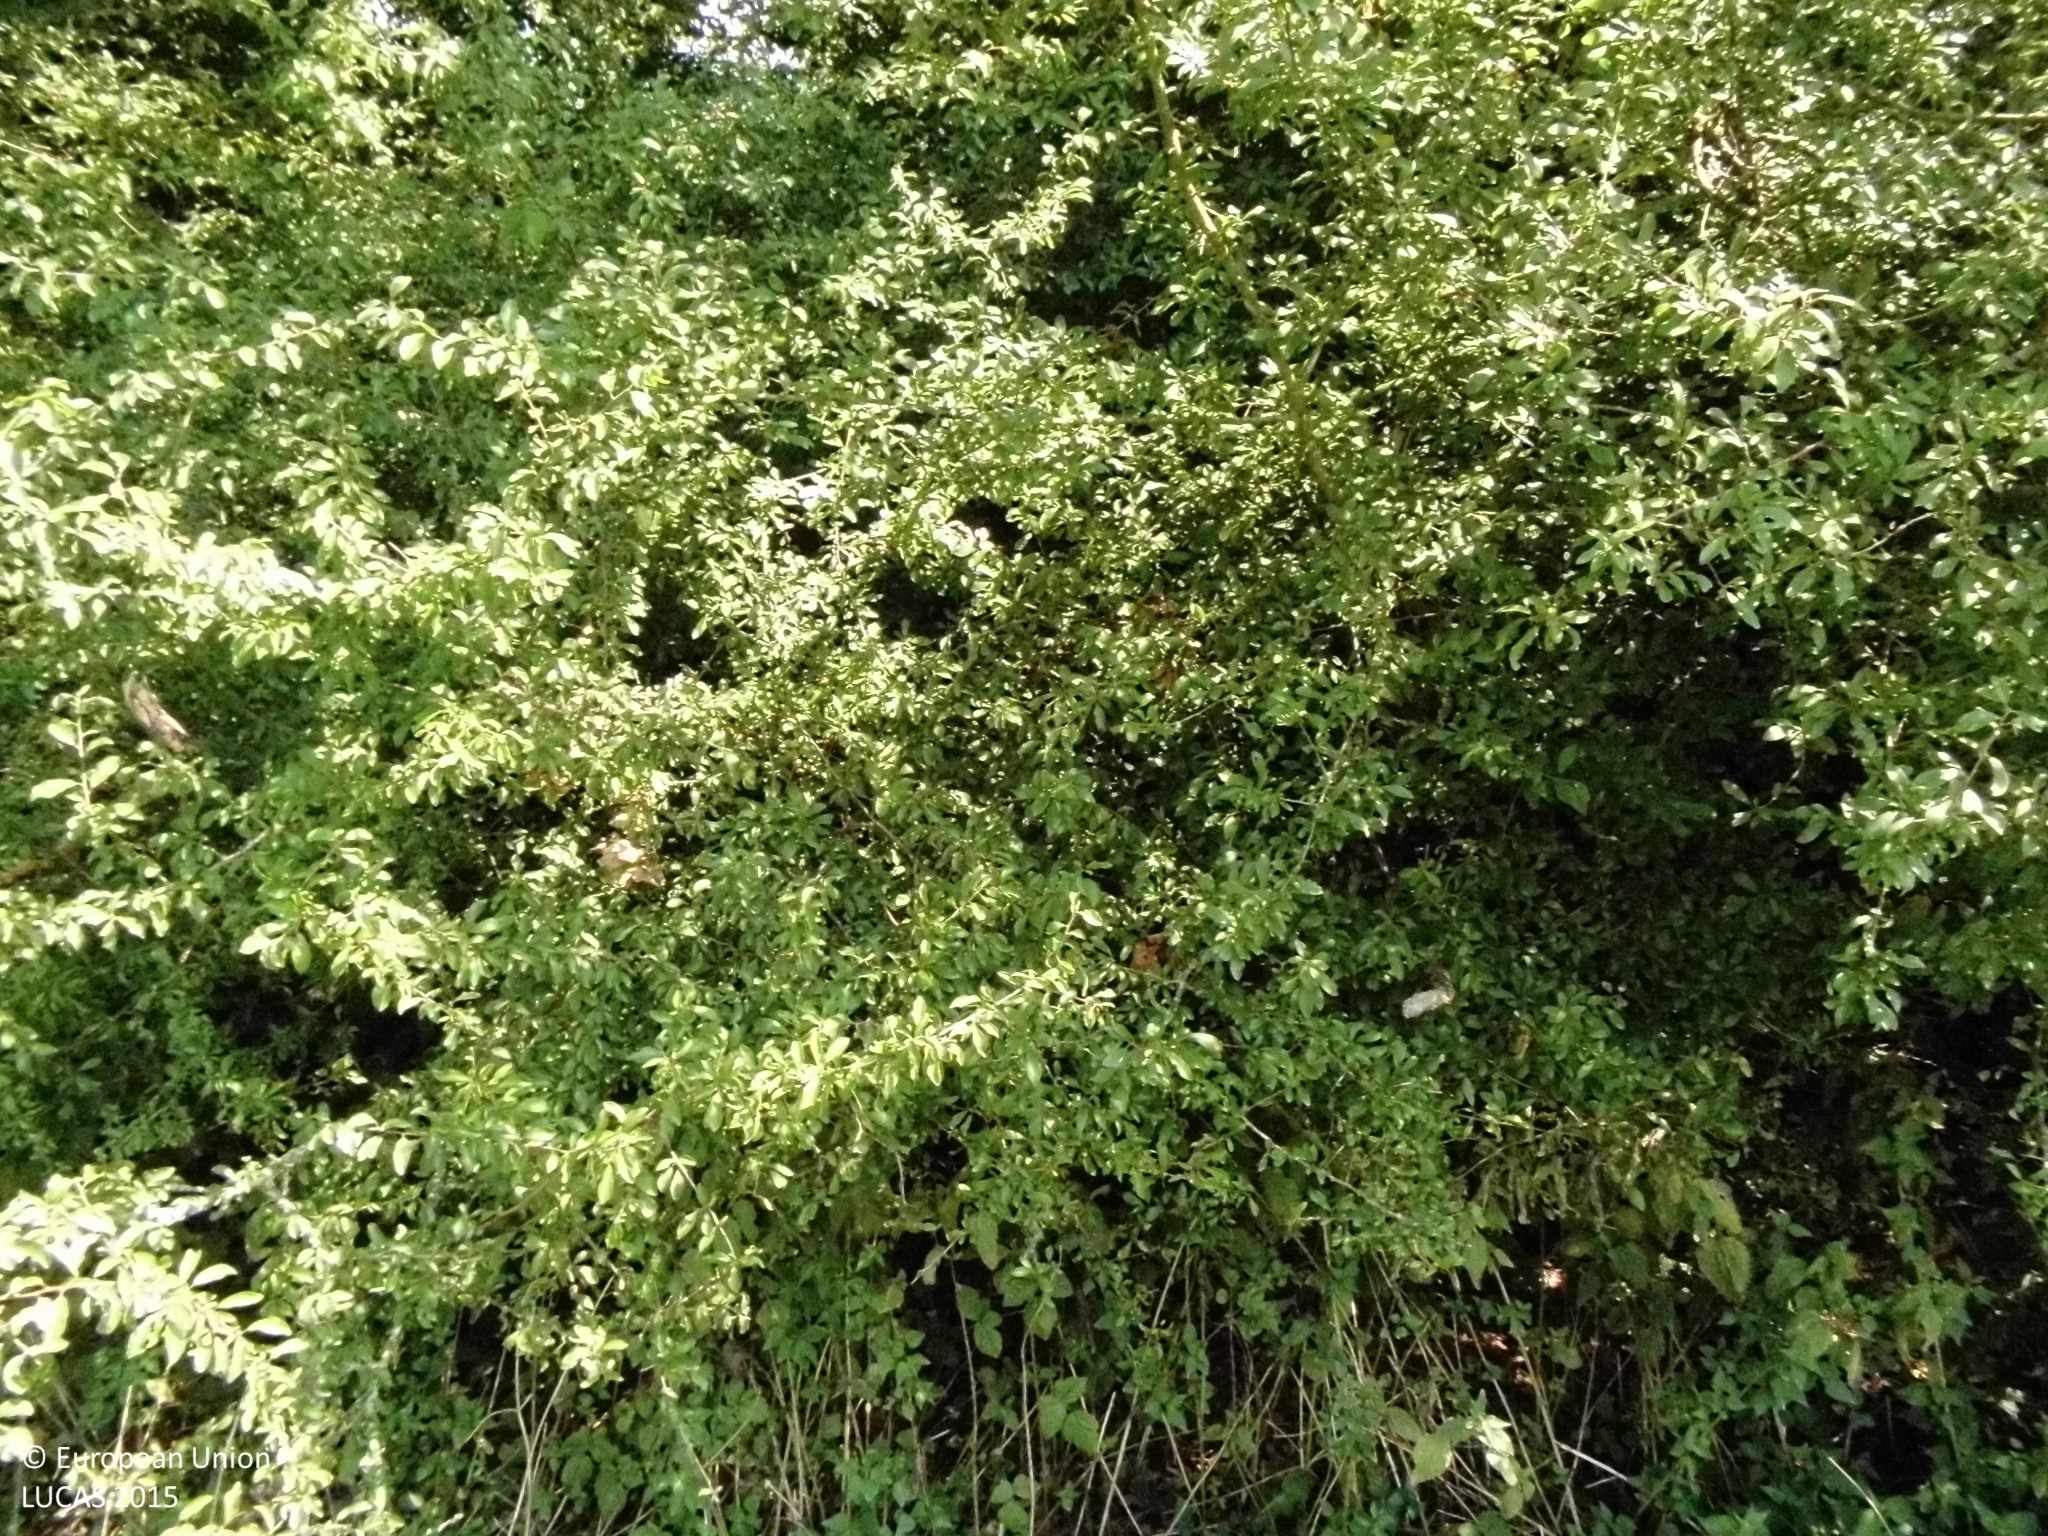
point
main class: Woodland
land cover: Broadleaved woodland
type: mesophytic deciduous forest
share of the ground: > 75 %
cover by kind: broadleaved forest trees 100 %
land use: Forestry
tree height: > 5 m
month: August
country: DE
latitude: 50.5645
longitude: 8.1227
